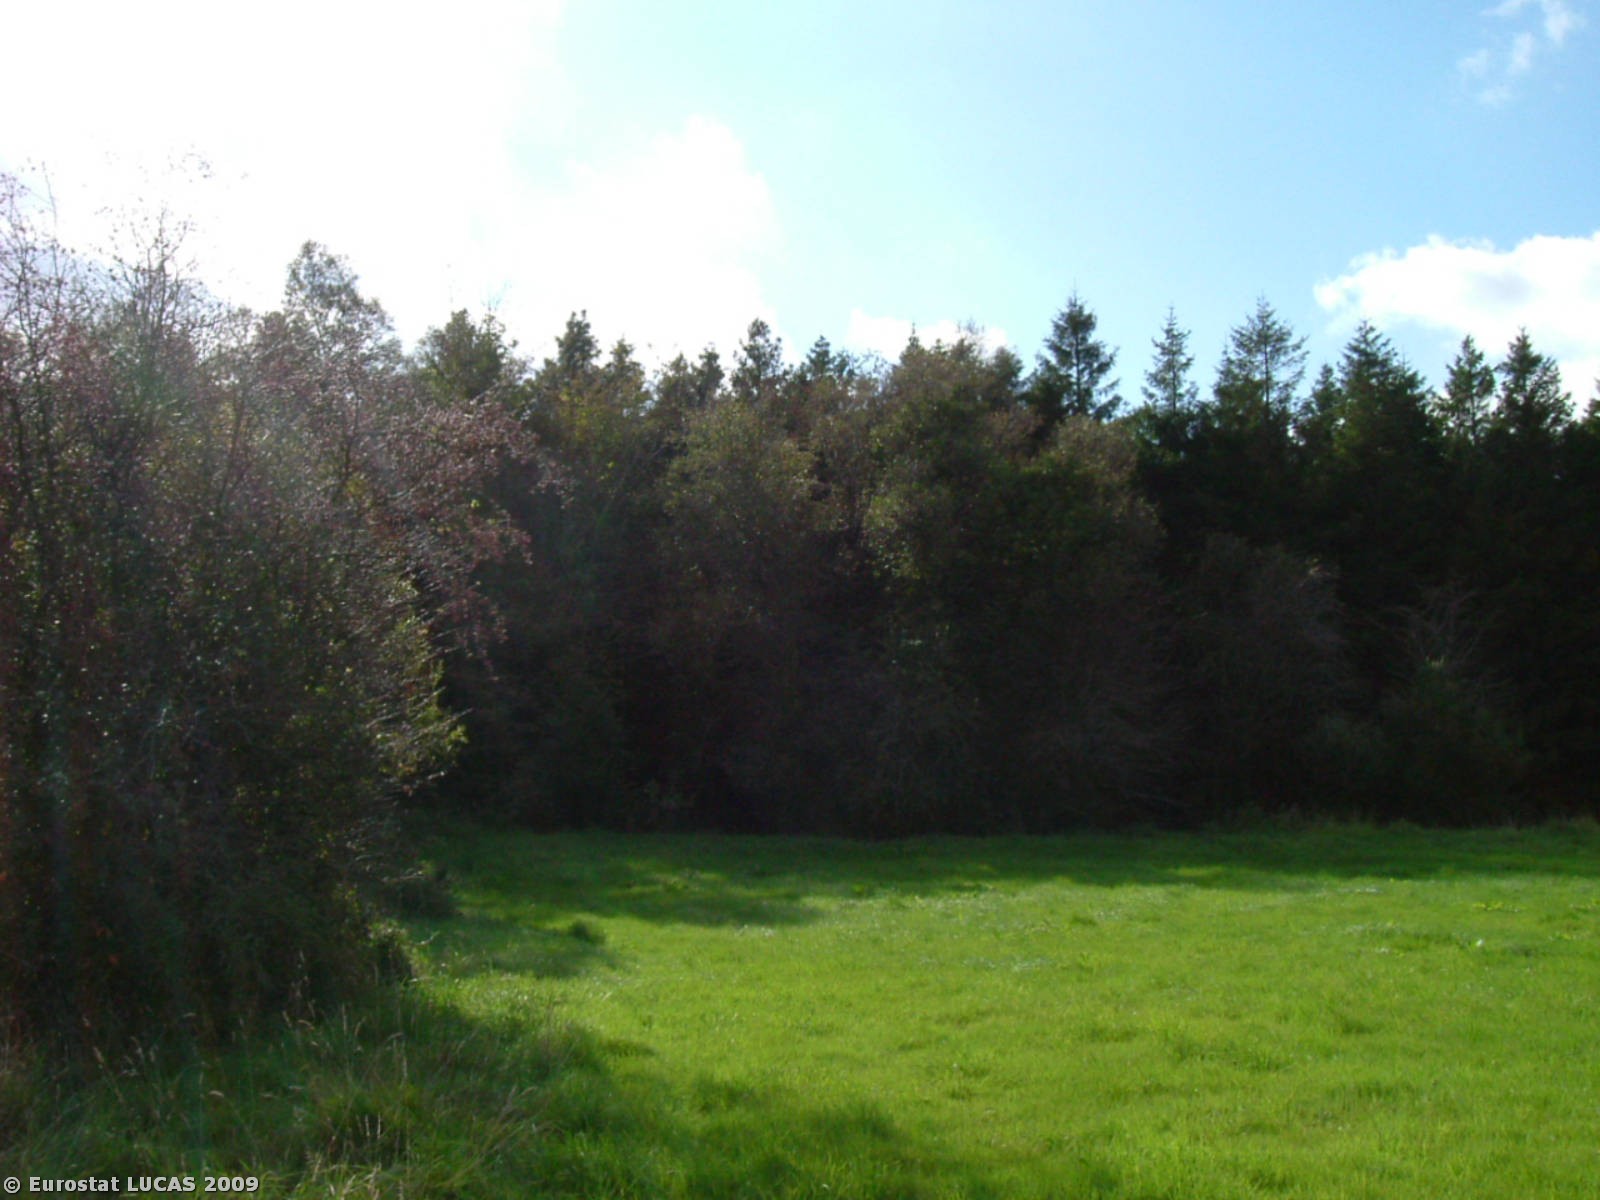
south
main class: Wetlands
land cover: Peatbogs
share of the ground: > 75 %
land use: Mining and quarrying
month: September
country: IE
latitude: 52.8126
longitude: -7.7482
